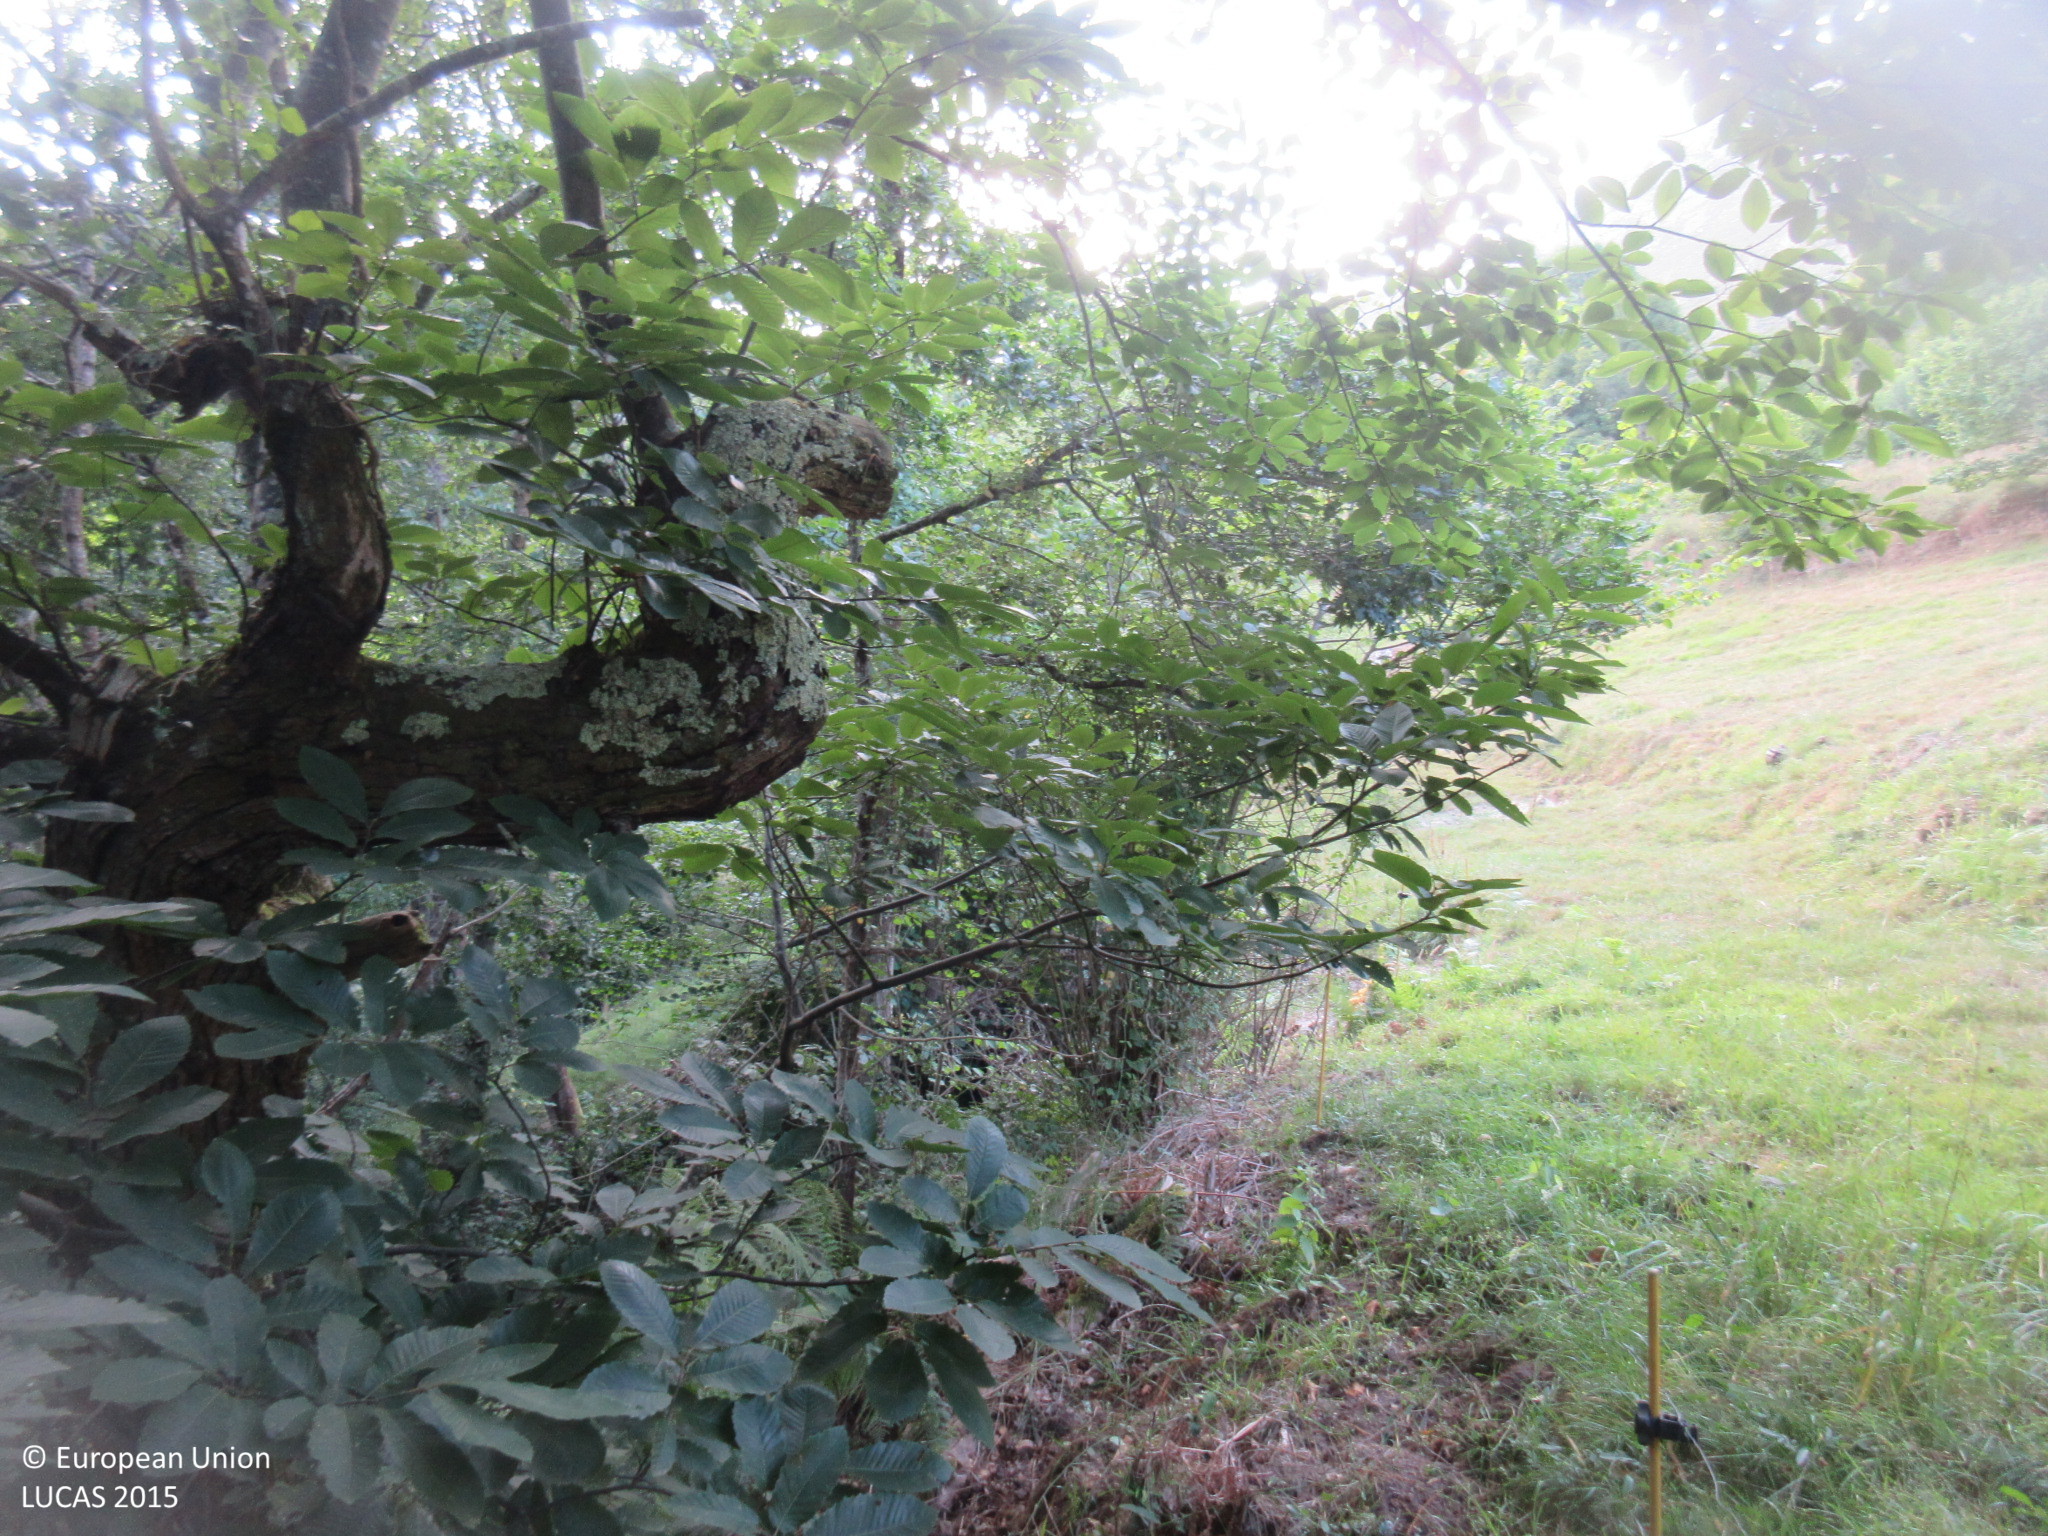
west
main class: Woodland
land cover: Broadleaved woodland
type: thermophilous deciduous forest
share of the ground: > 75 %
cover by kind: broadleaved forest trees 95 %, shrubs 5 %
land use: Forestry
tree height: > 5 m
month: July
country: ES
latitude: 43.3926
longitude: -5.0462
